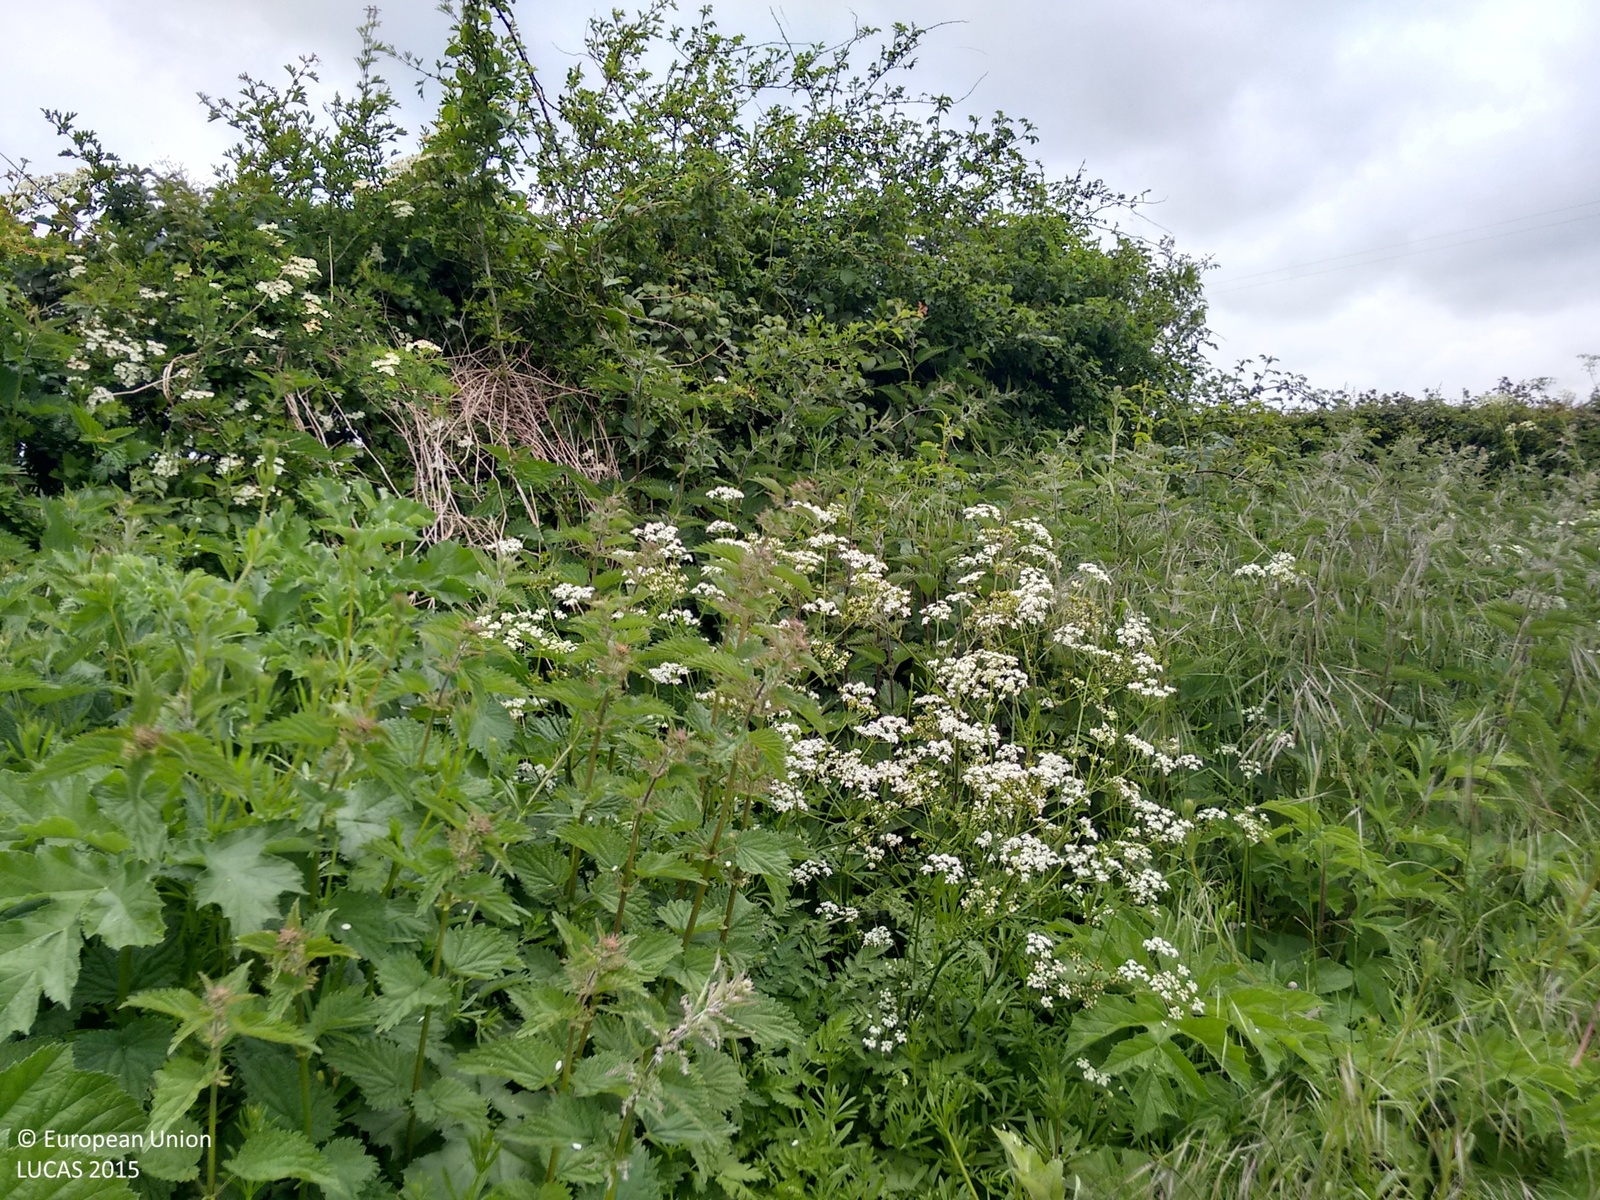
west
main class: Cropland
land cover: Rape and turnip rape
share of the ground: > 75 %
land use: Agriculture (excluding fallow land and kitchen gardens)
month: May
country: GB
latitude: 50.8062
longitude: -2.1364
